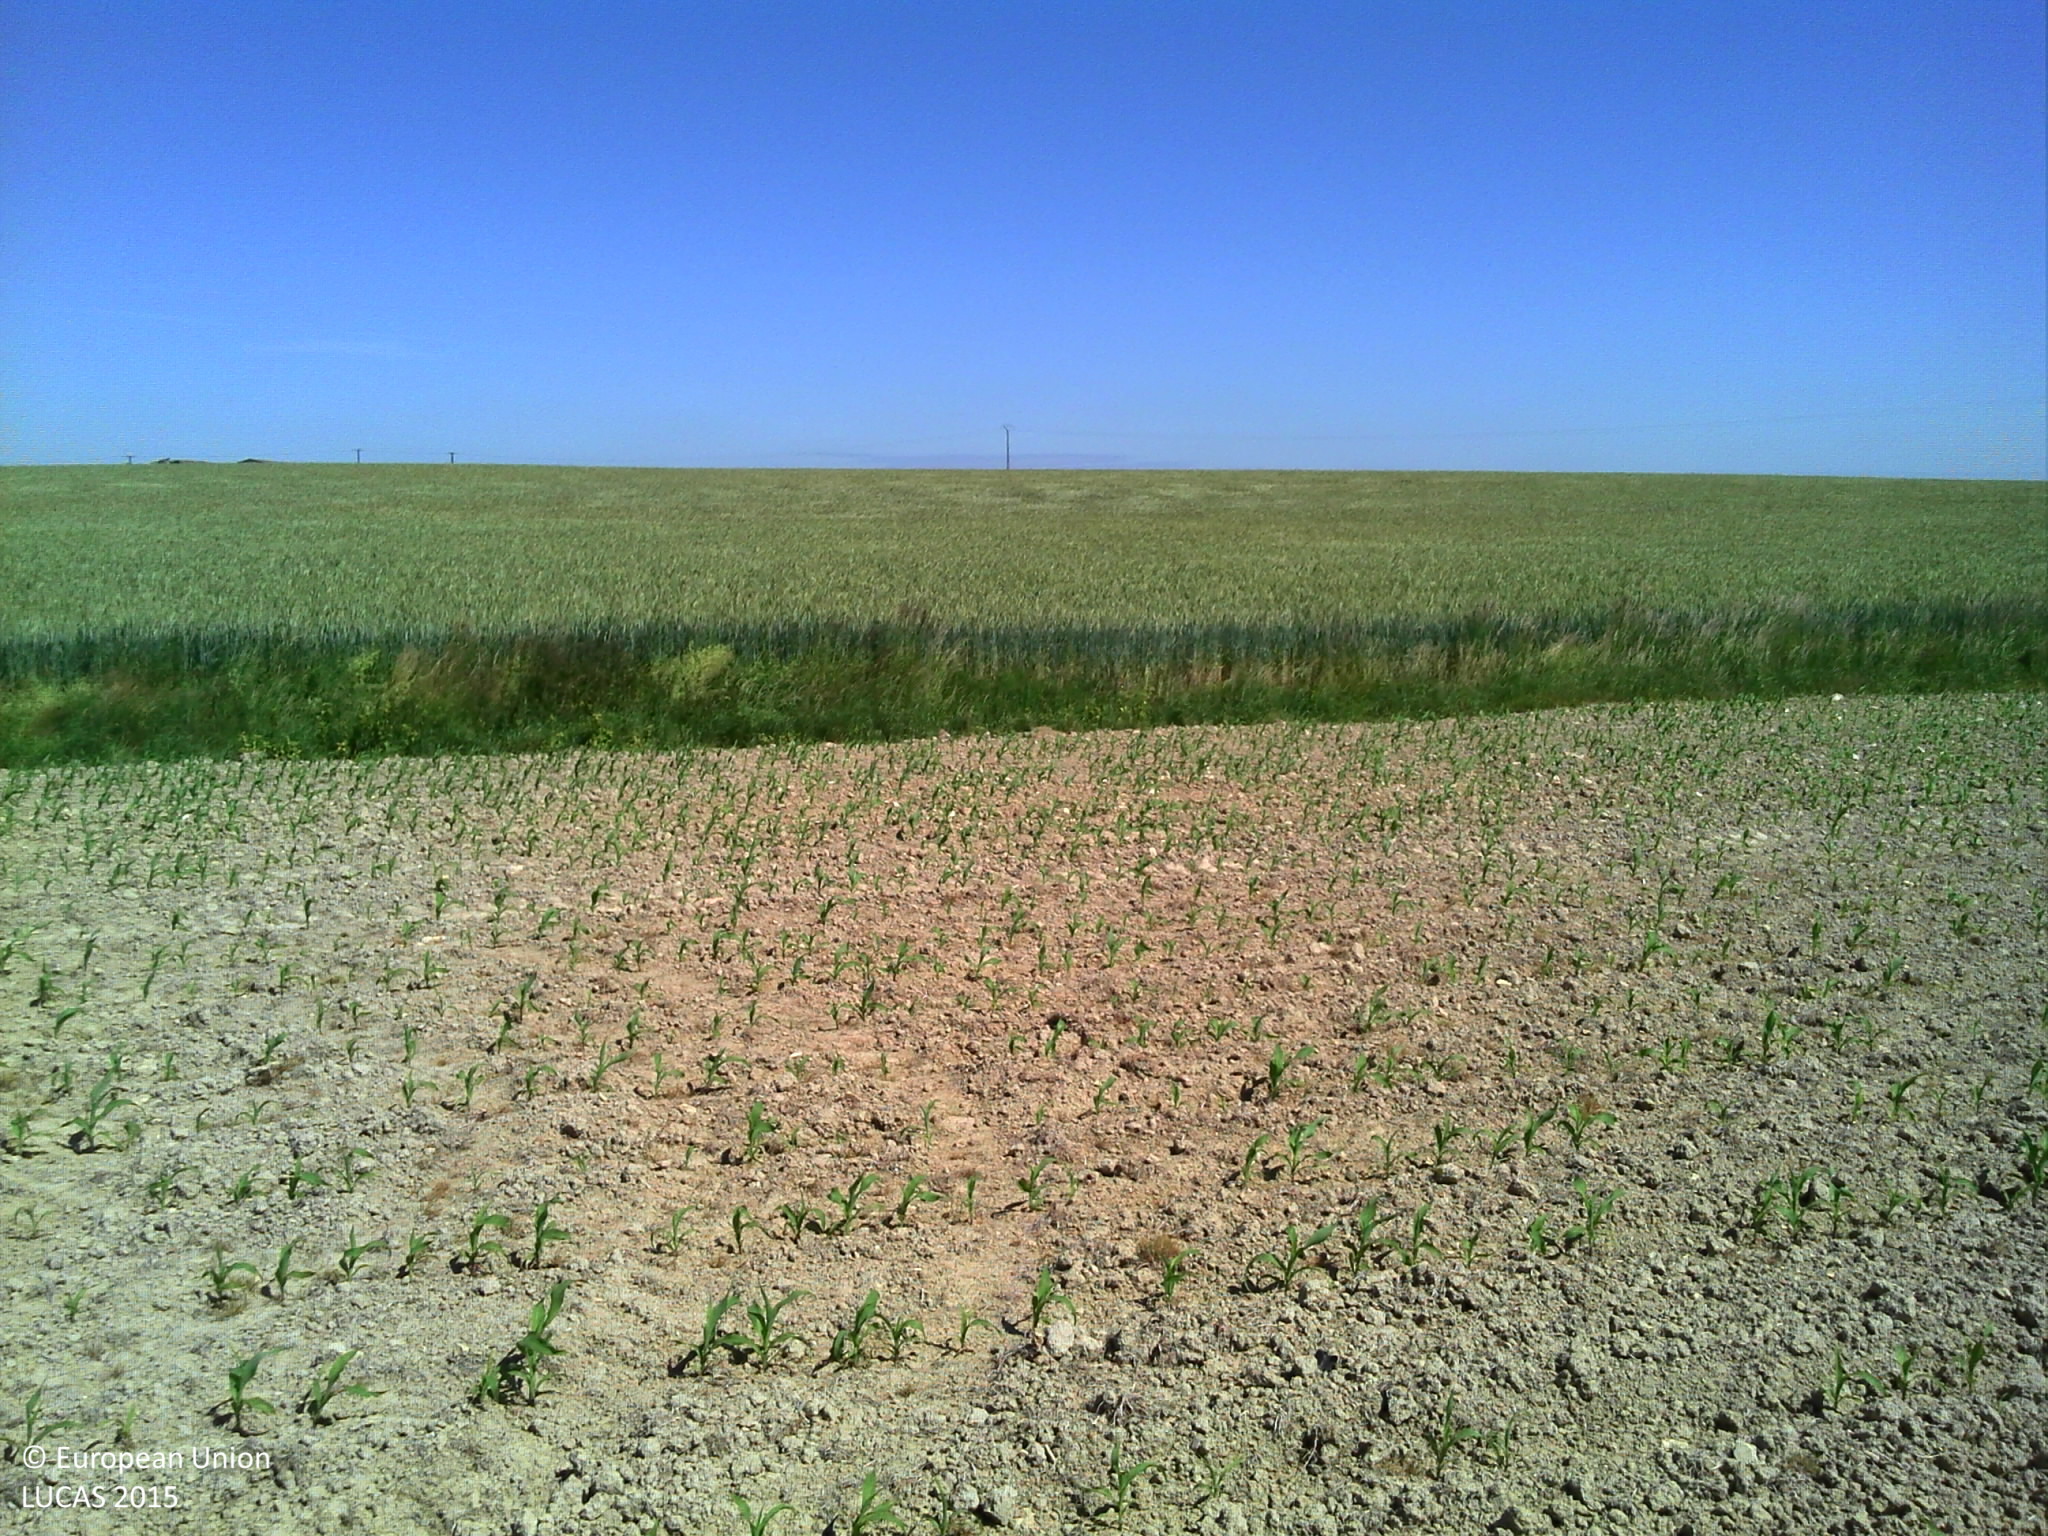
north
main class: Cropland
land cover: Maize
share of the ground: 10 - 25 %
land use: Agriculture (excluding fallow land and kitchen gardens)
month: June
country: FR
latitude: 46.9100
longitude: 0.5413
